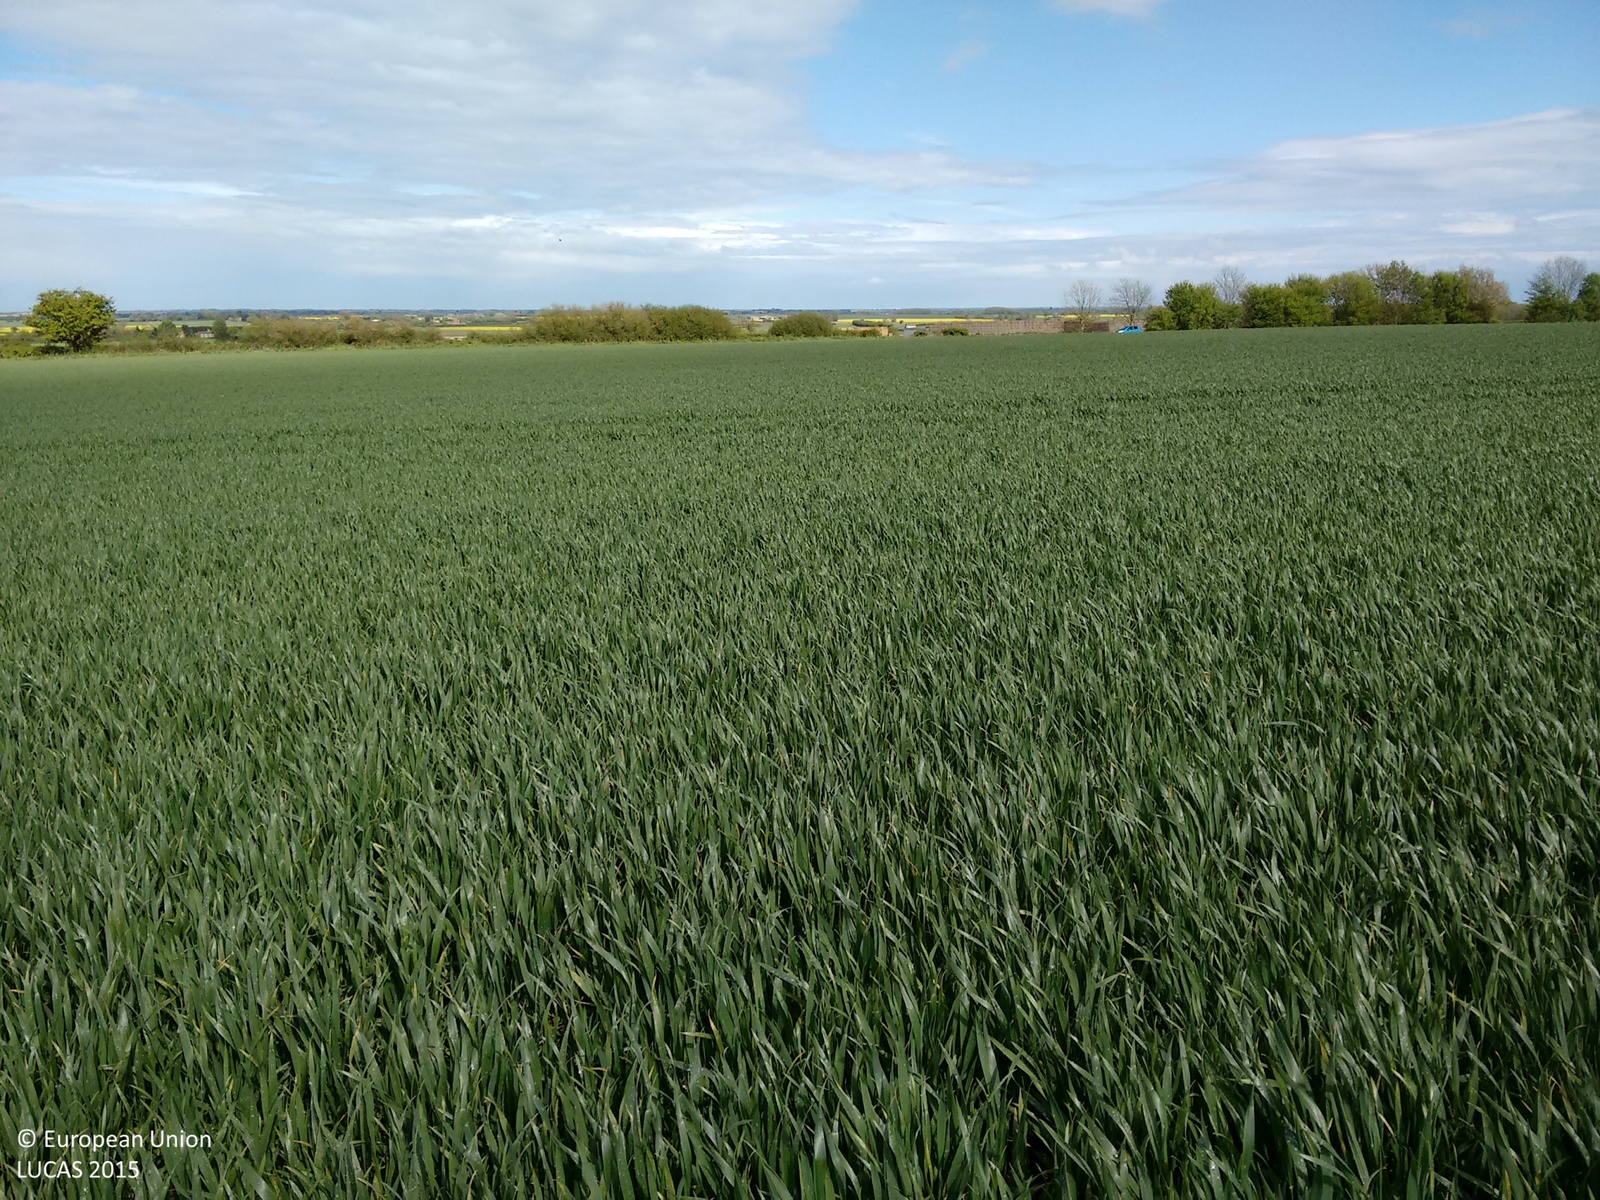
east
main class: Cropland
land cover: Common wheat
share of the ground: > 75 %
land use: Agriculture (excluding fallow land and kitchen gardens)
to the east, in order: Common wheat; Grassland without tree/shrub cover; Paved roads, cycling and walking lanes; Grass margins; Ditches and canals; Fences; Grass margins; Barley
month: May
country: GB
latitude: 53.3501
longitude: 0.0083
